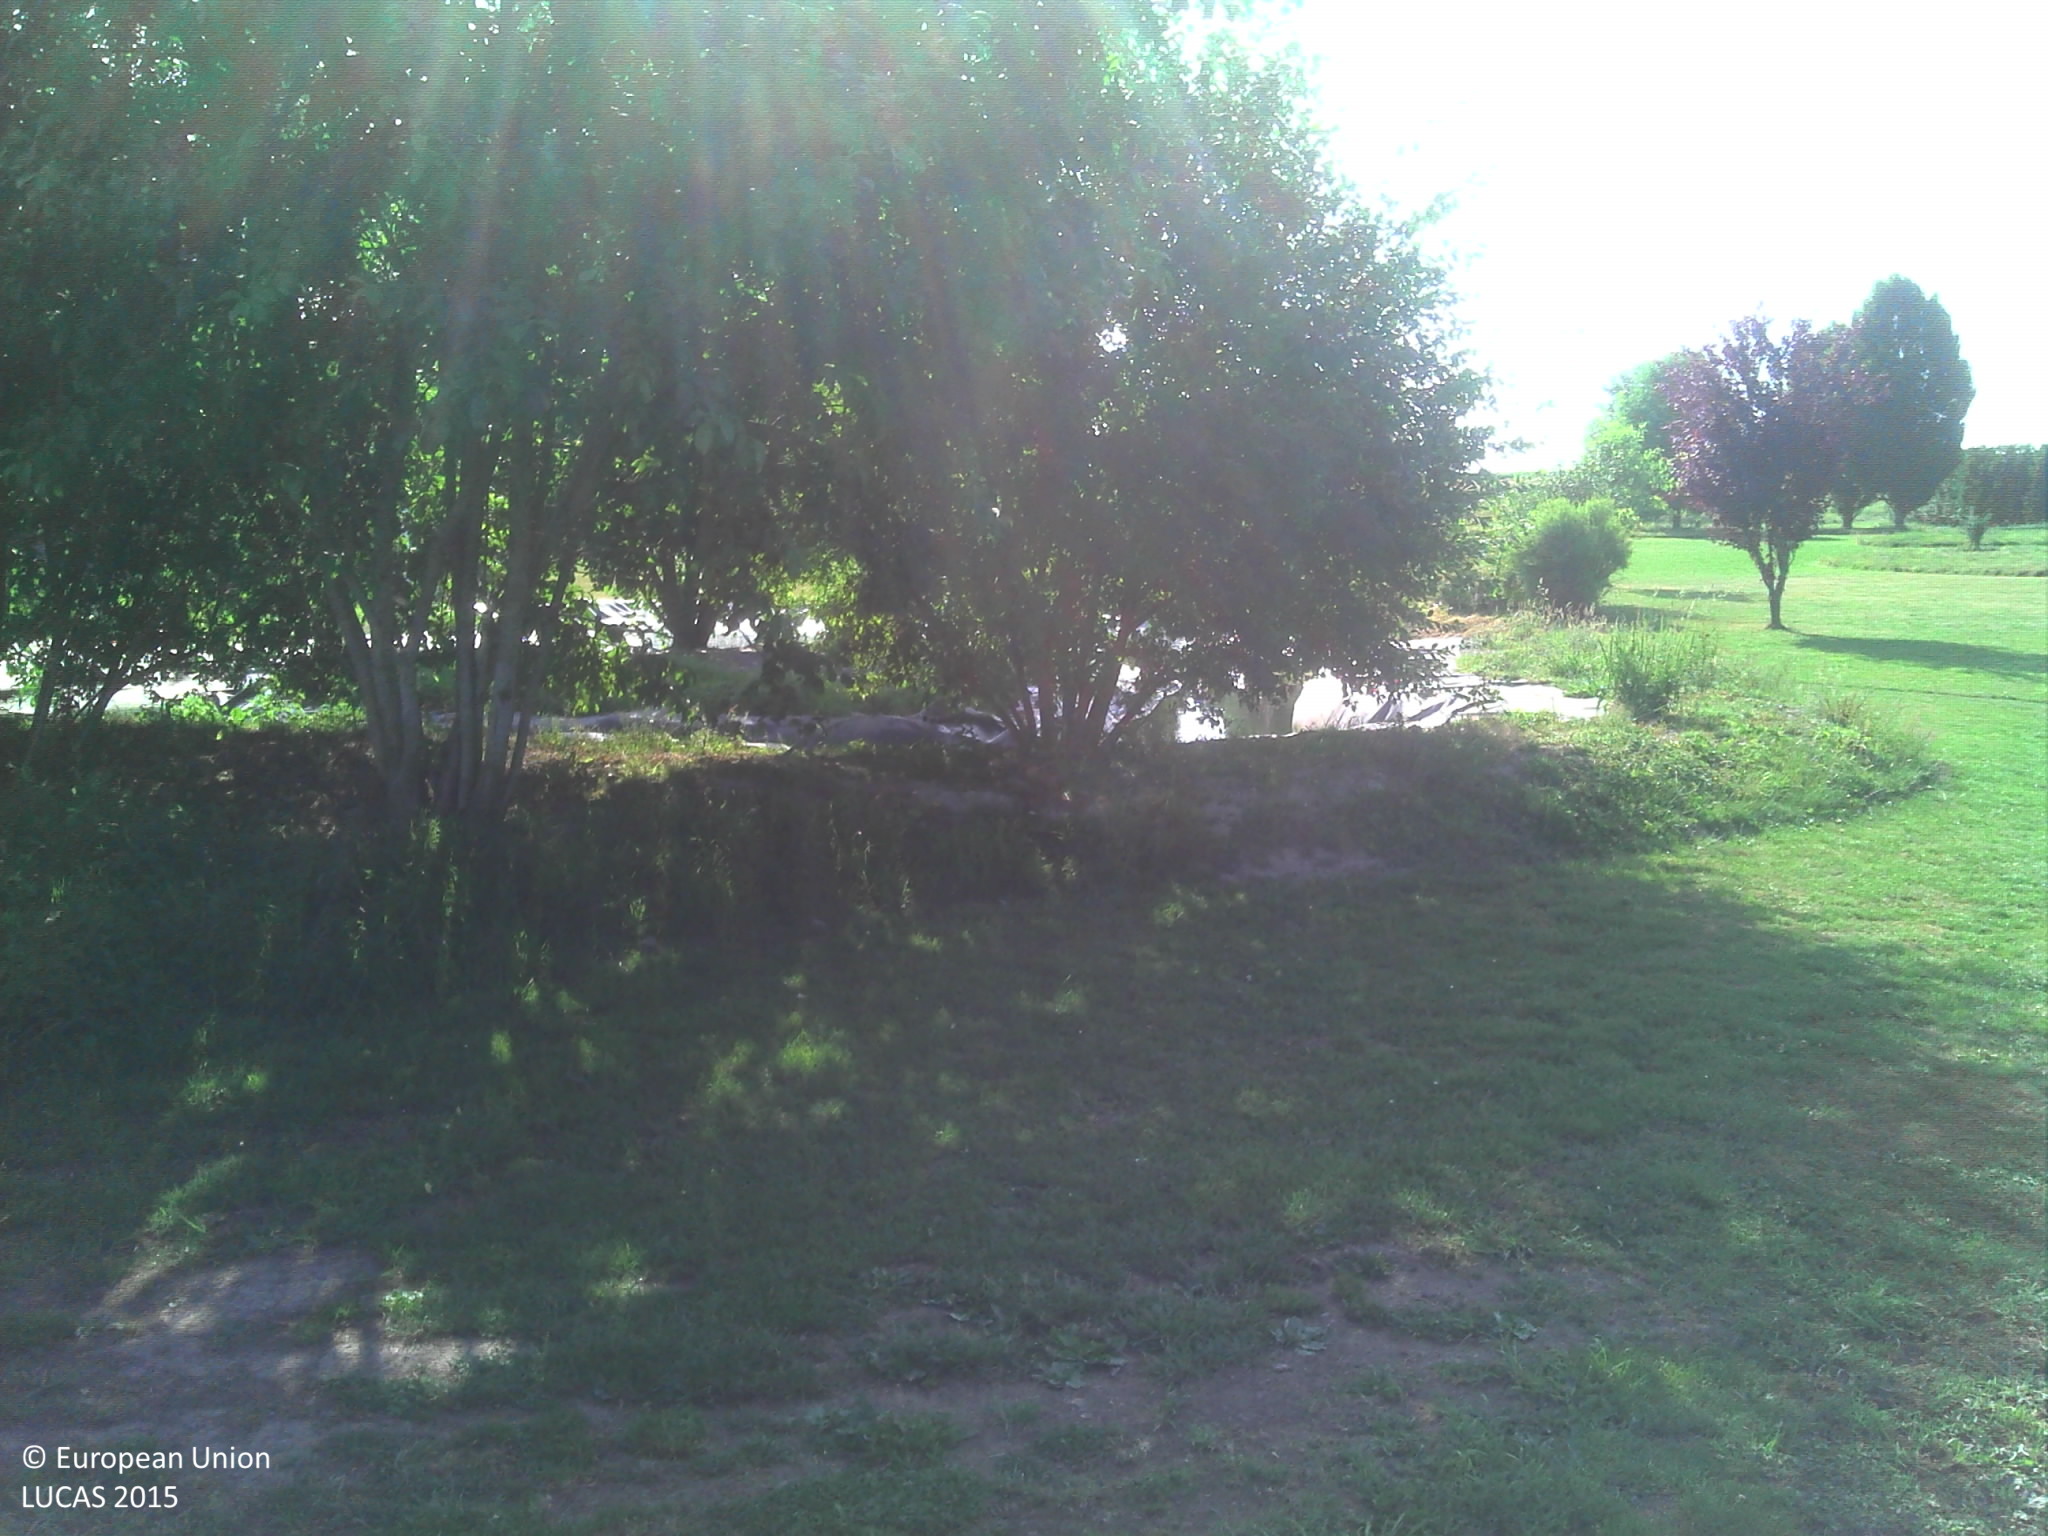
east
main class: Grassland
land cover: Grassland without tree/shrub cover
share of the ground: > 75 %
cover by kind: herbaceous plants 100 %
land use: Residential
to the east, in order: Grassland without tree/shrub cover; Grassland with sparse tree/shrub cover; Fences; Barley; Fences; Other bare soil; Maize
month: July
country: BE
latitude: 49.9735
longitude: 5.6063
